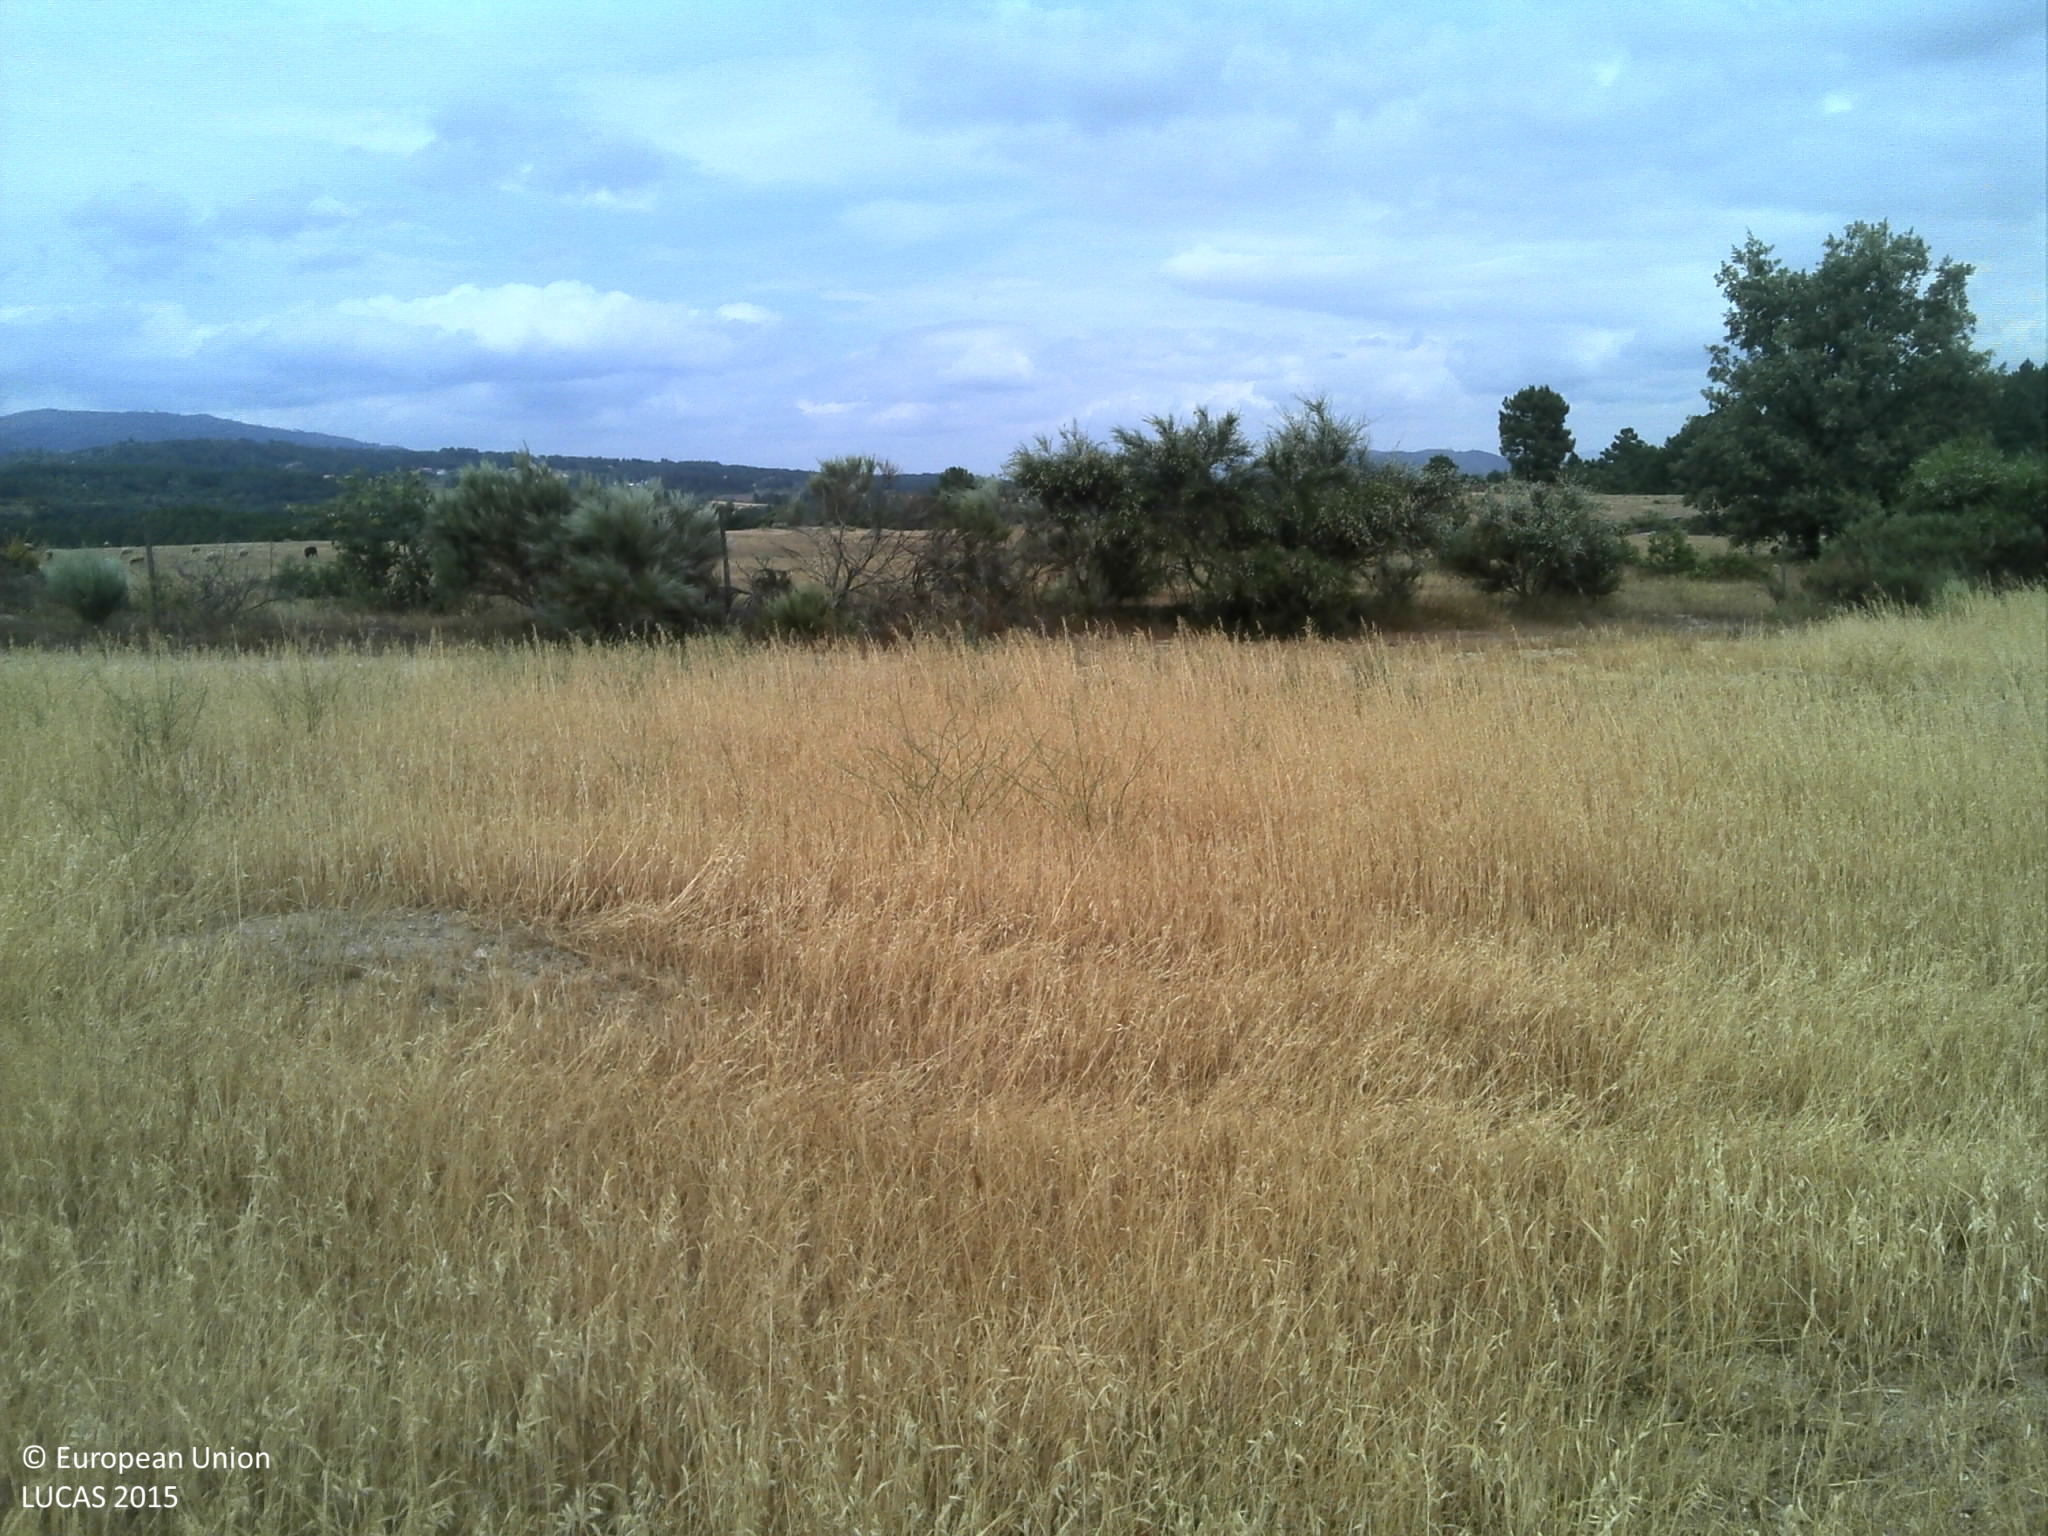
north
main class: Cropland
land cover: Oats
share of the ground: 50 - 75 %
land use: Agriculture (excluding fallow land and kitchen gardens)
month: June
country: PT
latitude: 40.2764
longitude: -7.4532
